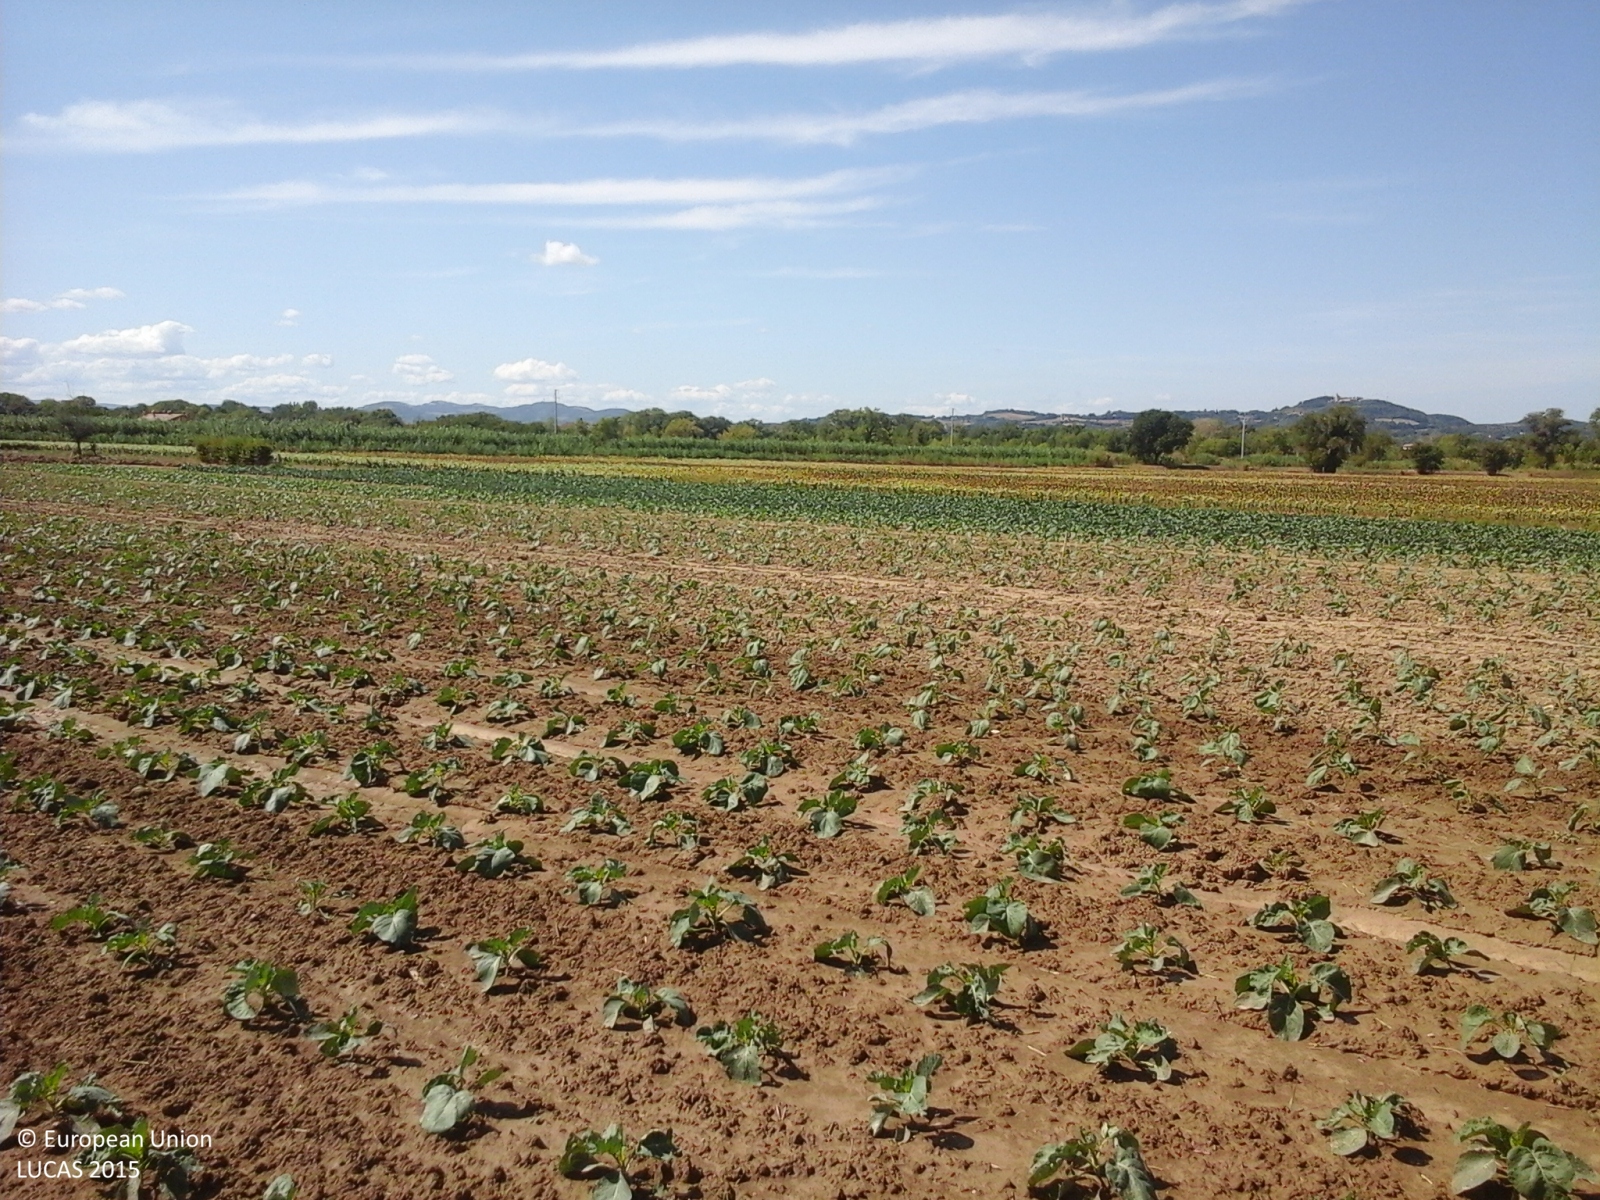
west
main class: Cropland
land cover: Other fresh vegetables
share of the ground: 10 - 25 %
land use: Agriculture (excluding fallow land and kitchen gardens)
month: September
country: IT
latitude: 43.8007
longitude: 13.0381
